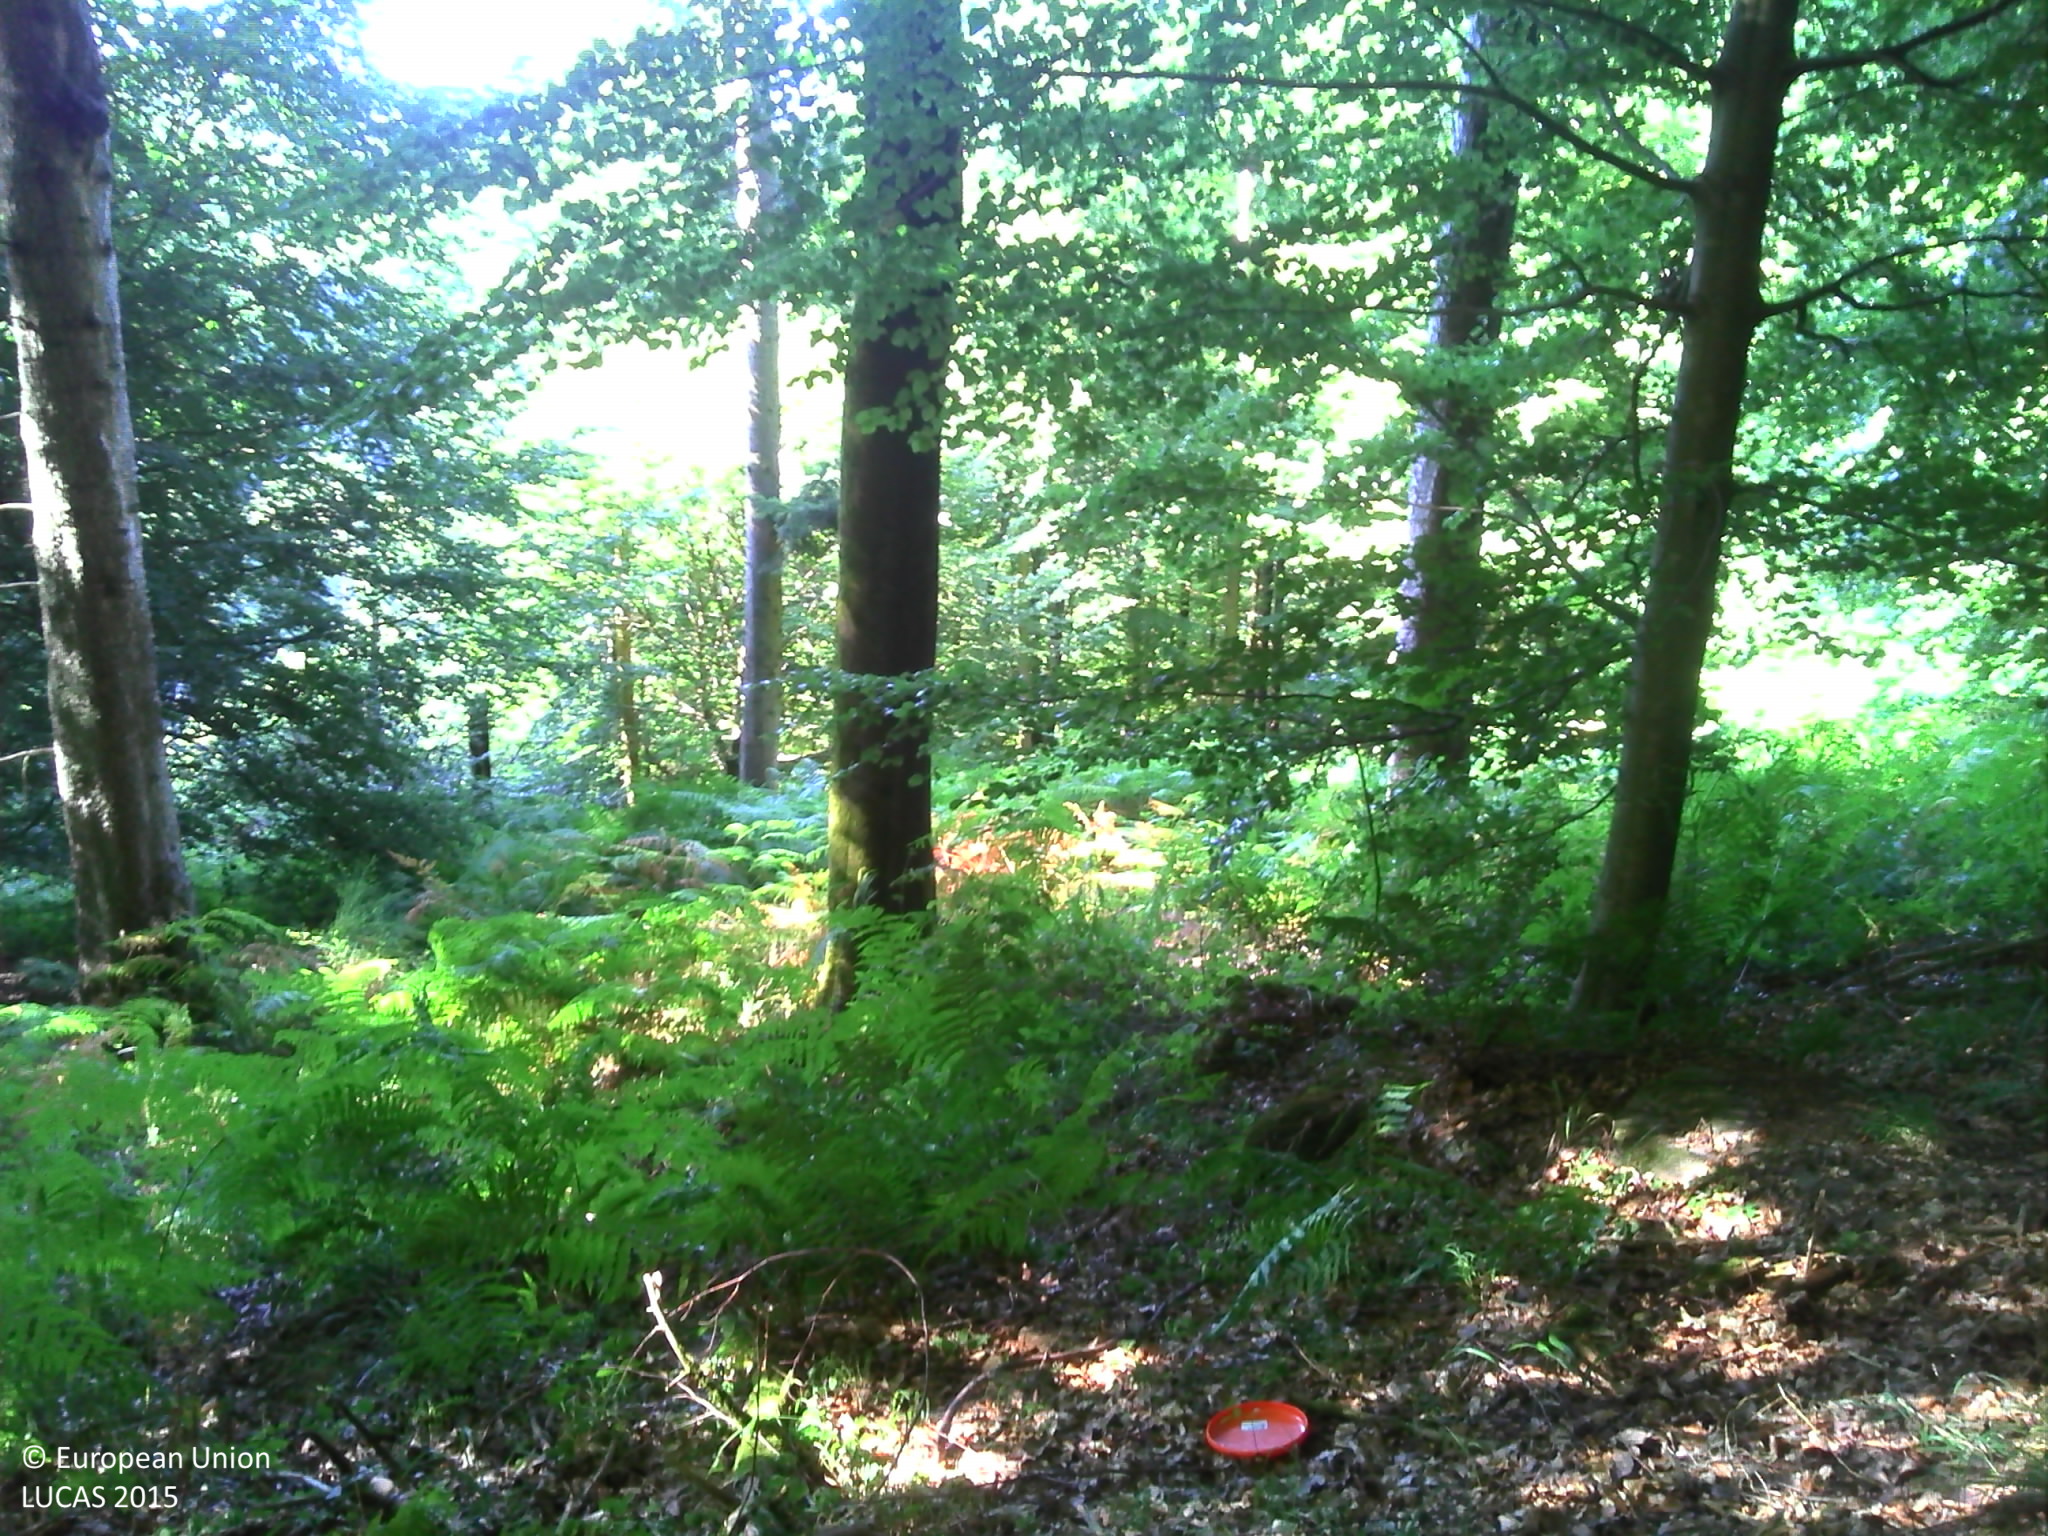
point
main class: Woodland
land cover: Broadleaved woodland
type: beech forest
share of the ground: > 75 %
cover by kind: broadleaved forest trees 95 %, coniferous forest trees 5 %
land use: Forestry
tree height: > 5 m
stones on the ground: < 10 %
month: July
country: FR
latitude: 48.7851
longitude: 7.3194
